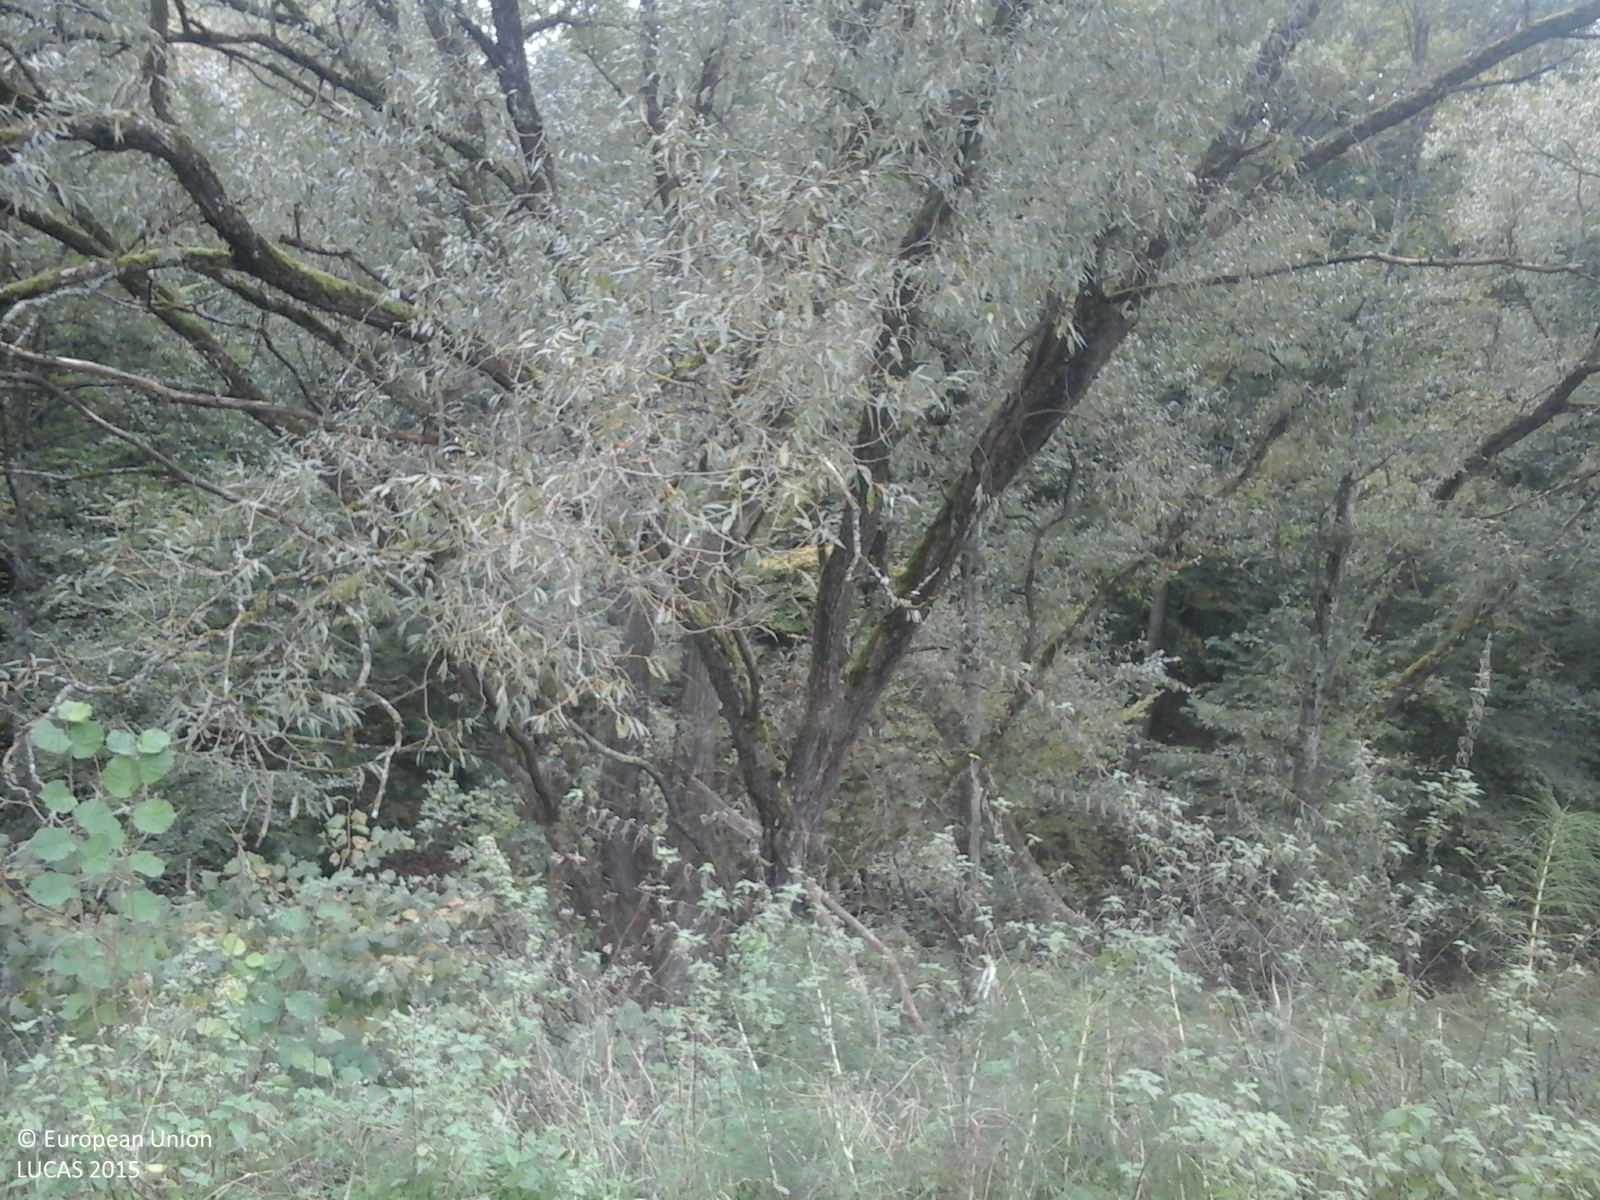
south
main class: Grassland
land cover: Grassland without tree/shrub cover
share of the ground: > 75 %
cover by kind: herbaceous plants 100 %
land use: Agriculture (excluding fallow land and kitchen gardens)
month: October
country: RO
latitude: 45.8515
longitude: 24.7555
